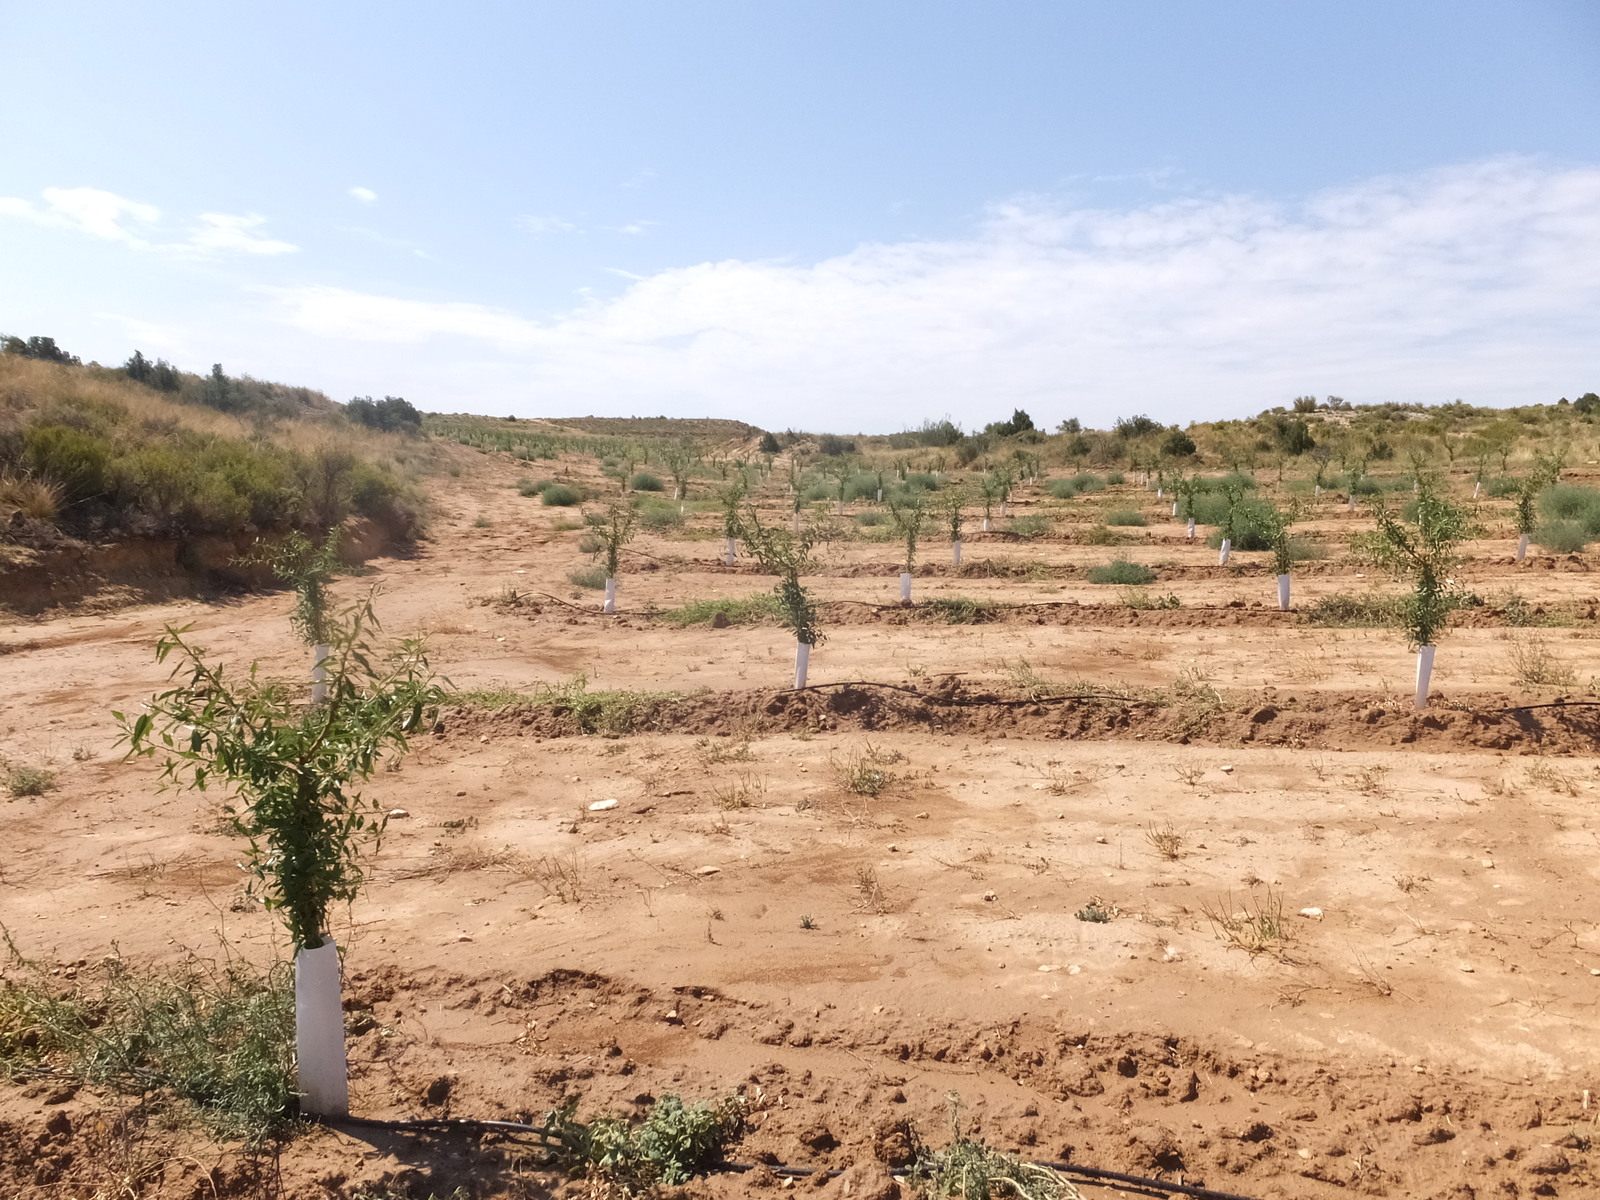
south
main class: Cropland
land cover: Nuts trees
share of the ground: 10 - 25 %
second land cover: Spontaneously vegetated surfaces
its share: < 10 %
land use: Agriculture (excluding fallow land and kitchen gardens)
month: July
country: ES
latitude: 41.1898
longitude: -0.0391
